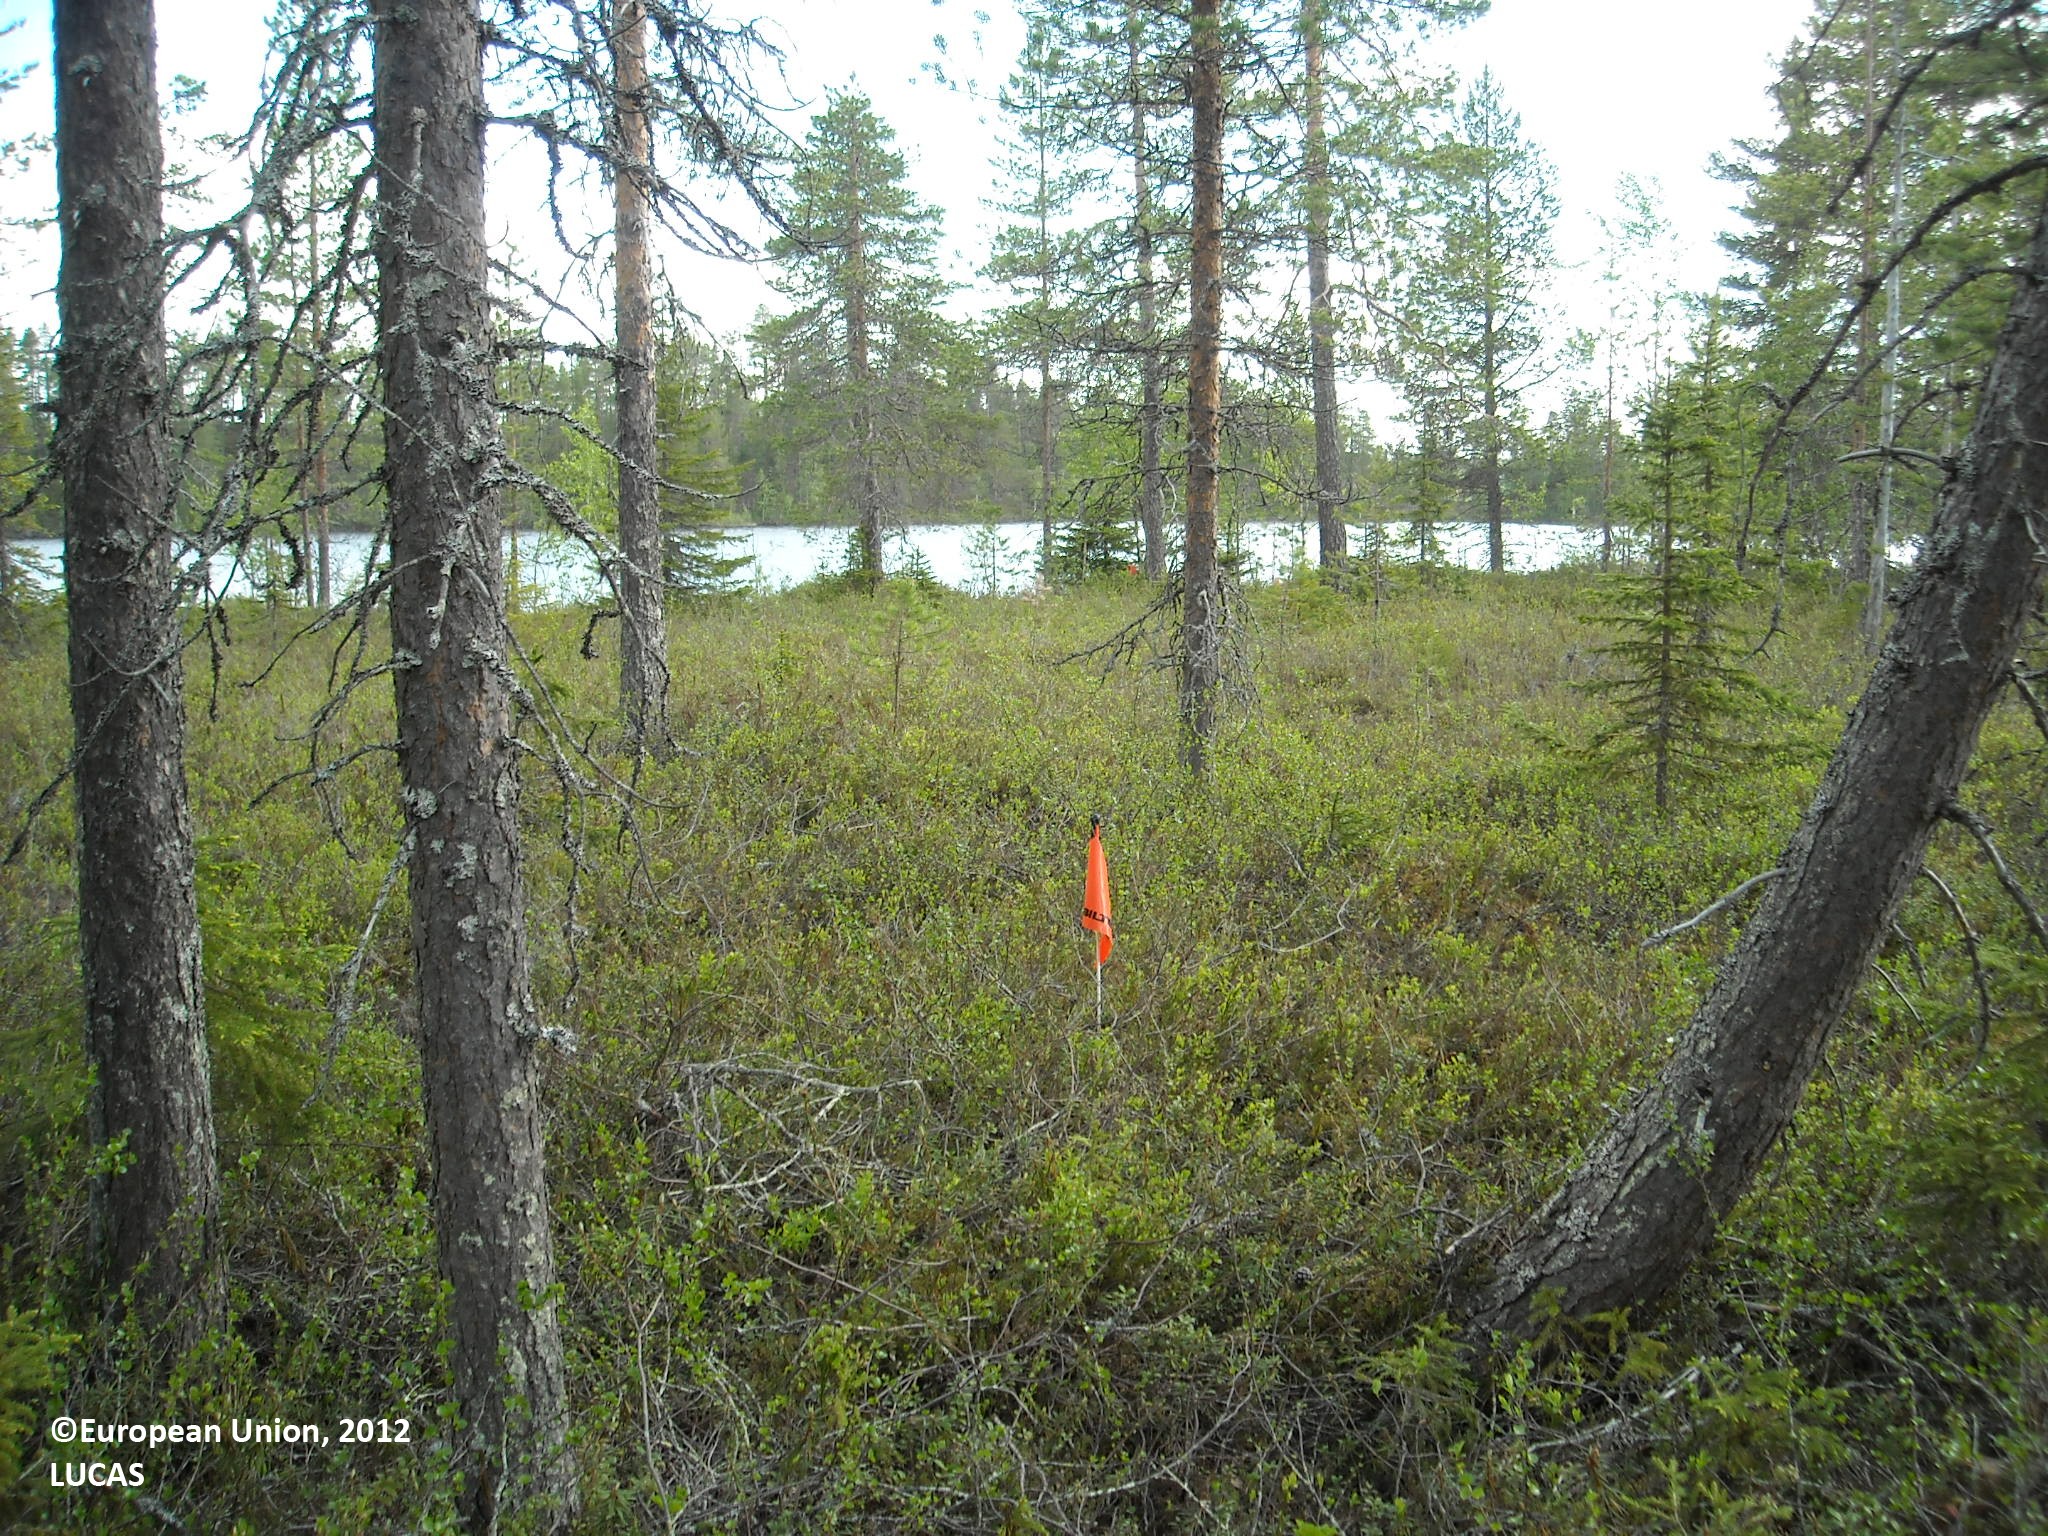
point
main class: Woodland
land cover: Pine dominated coniferous woodland
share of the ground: 25 - 50 %
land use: Forestry
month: June
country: FI
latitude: 65.7250
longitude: 27.9947
